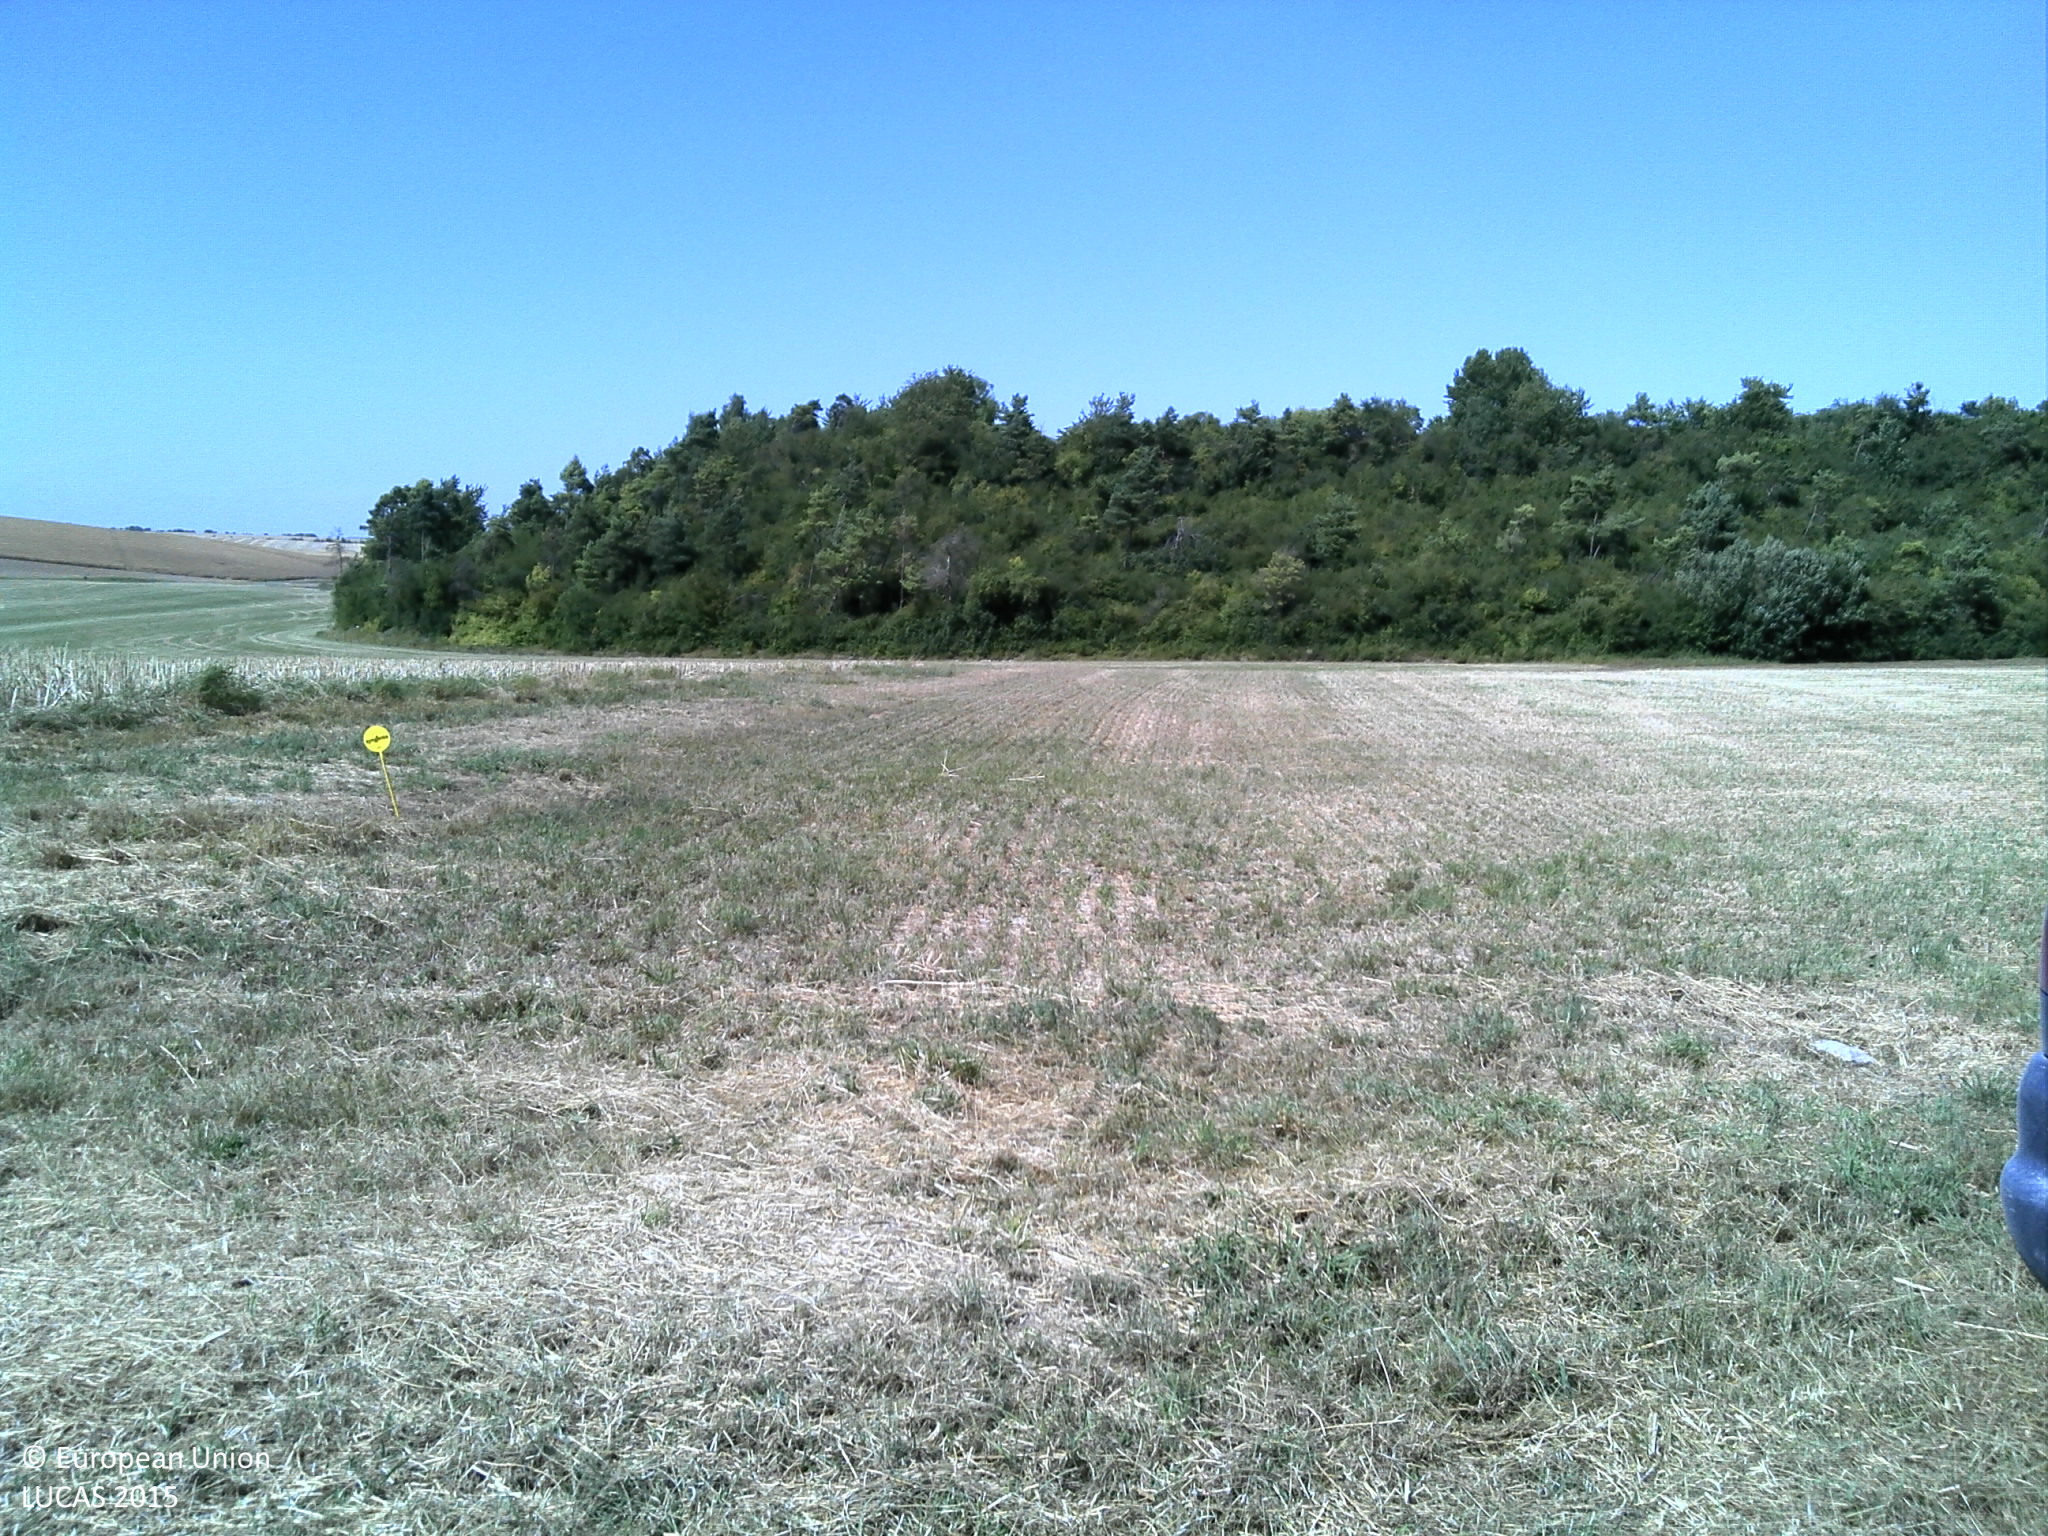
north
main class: Cropland
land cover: Barley
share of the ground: > 75 %
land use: Agriculture (excluding fallow land and kitchen gardens)
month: July
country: FR
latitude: 48.8685
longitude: 4.6394
